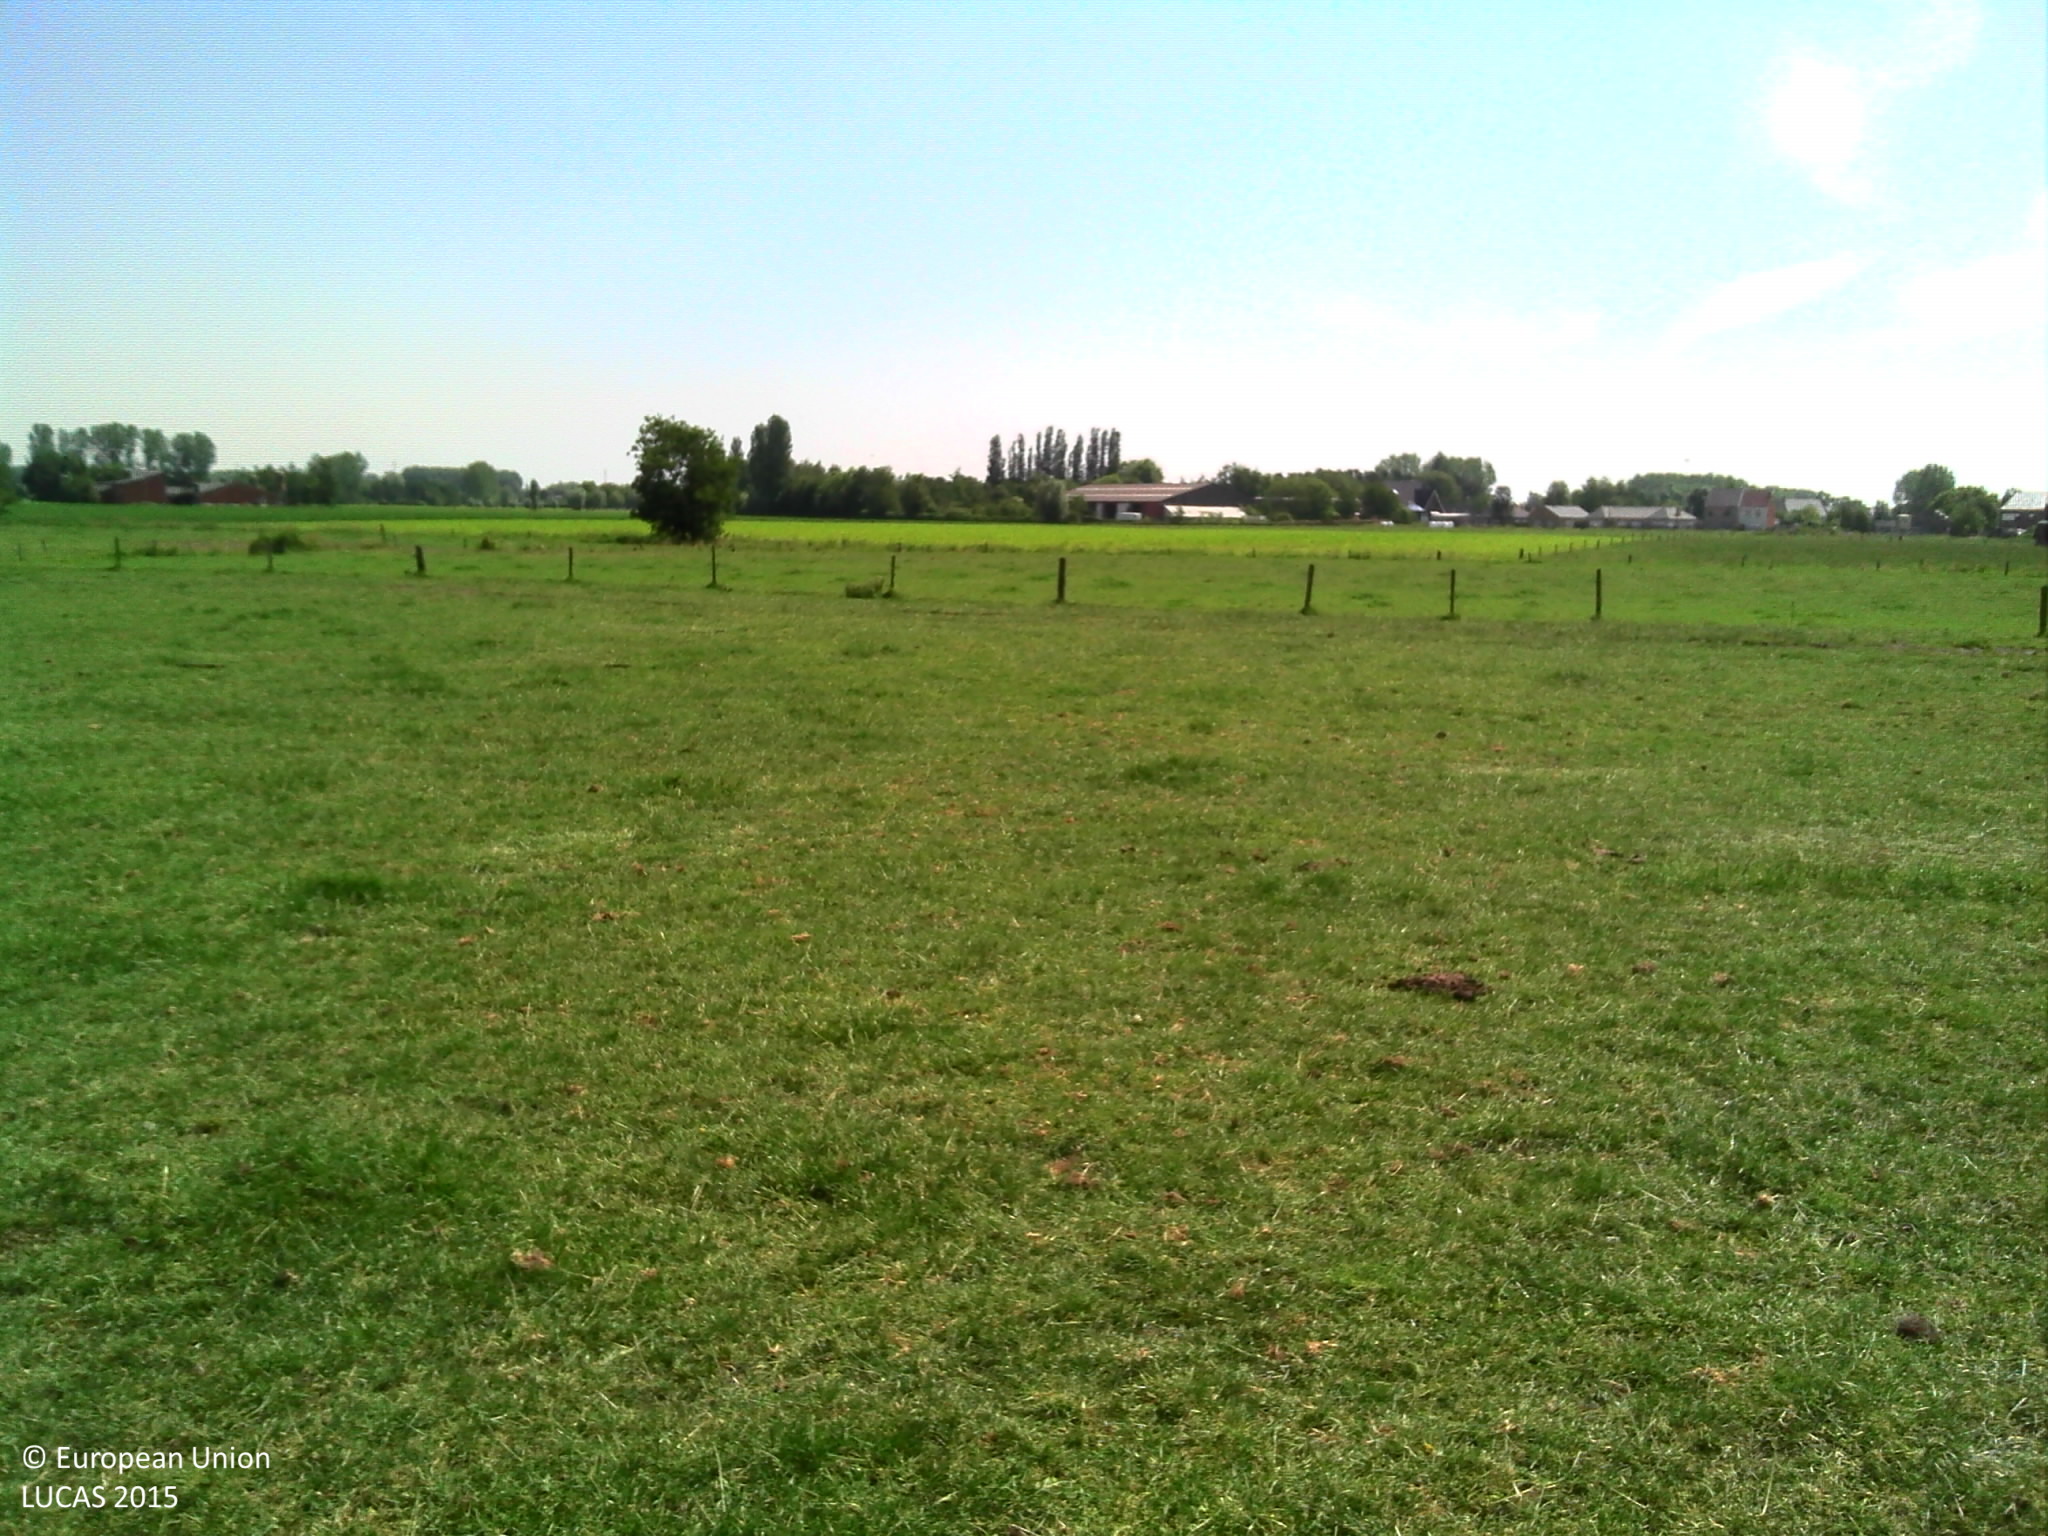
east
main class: Grassland
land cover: Grassland without tree/shrub cover
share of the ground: > 75 %
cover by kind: herbaceous plants 100 %
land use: Agriculture (excluding fallow land and kitchen gardens)
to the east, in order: Grassland without tree/shrub cover; Fences; Grassland without tree/shrub cover; Fences; Inland fresh running water; Grass margins; Maize
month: June
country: BE
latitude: 51.0950
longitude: 4.0972
